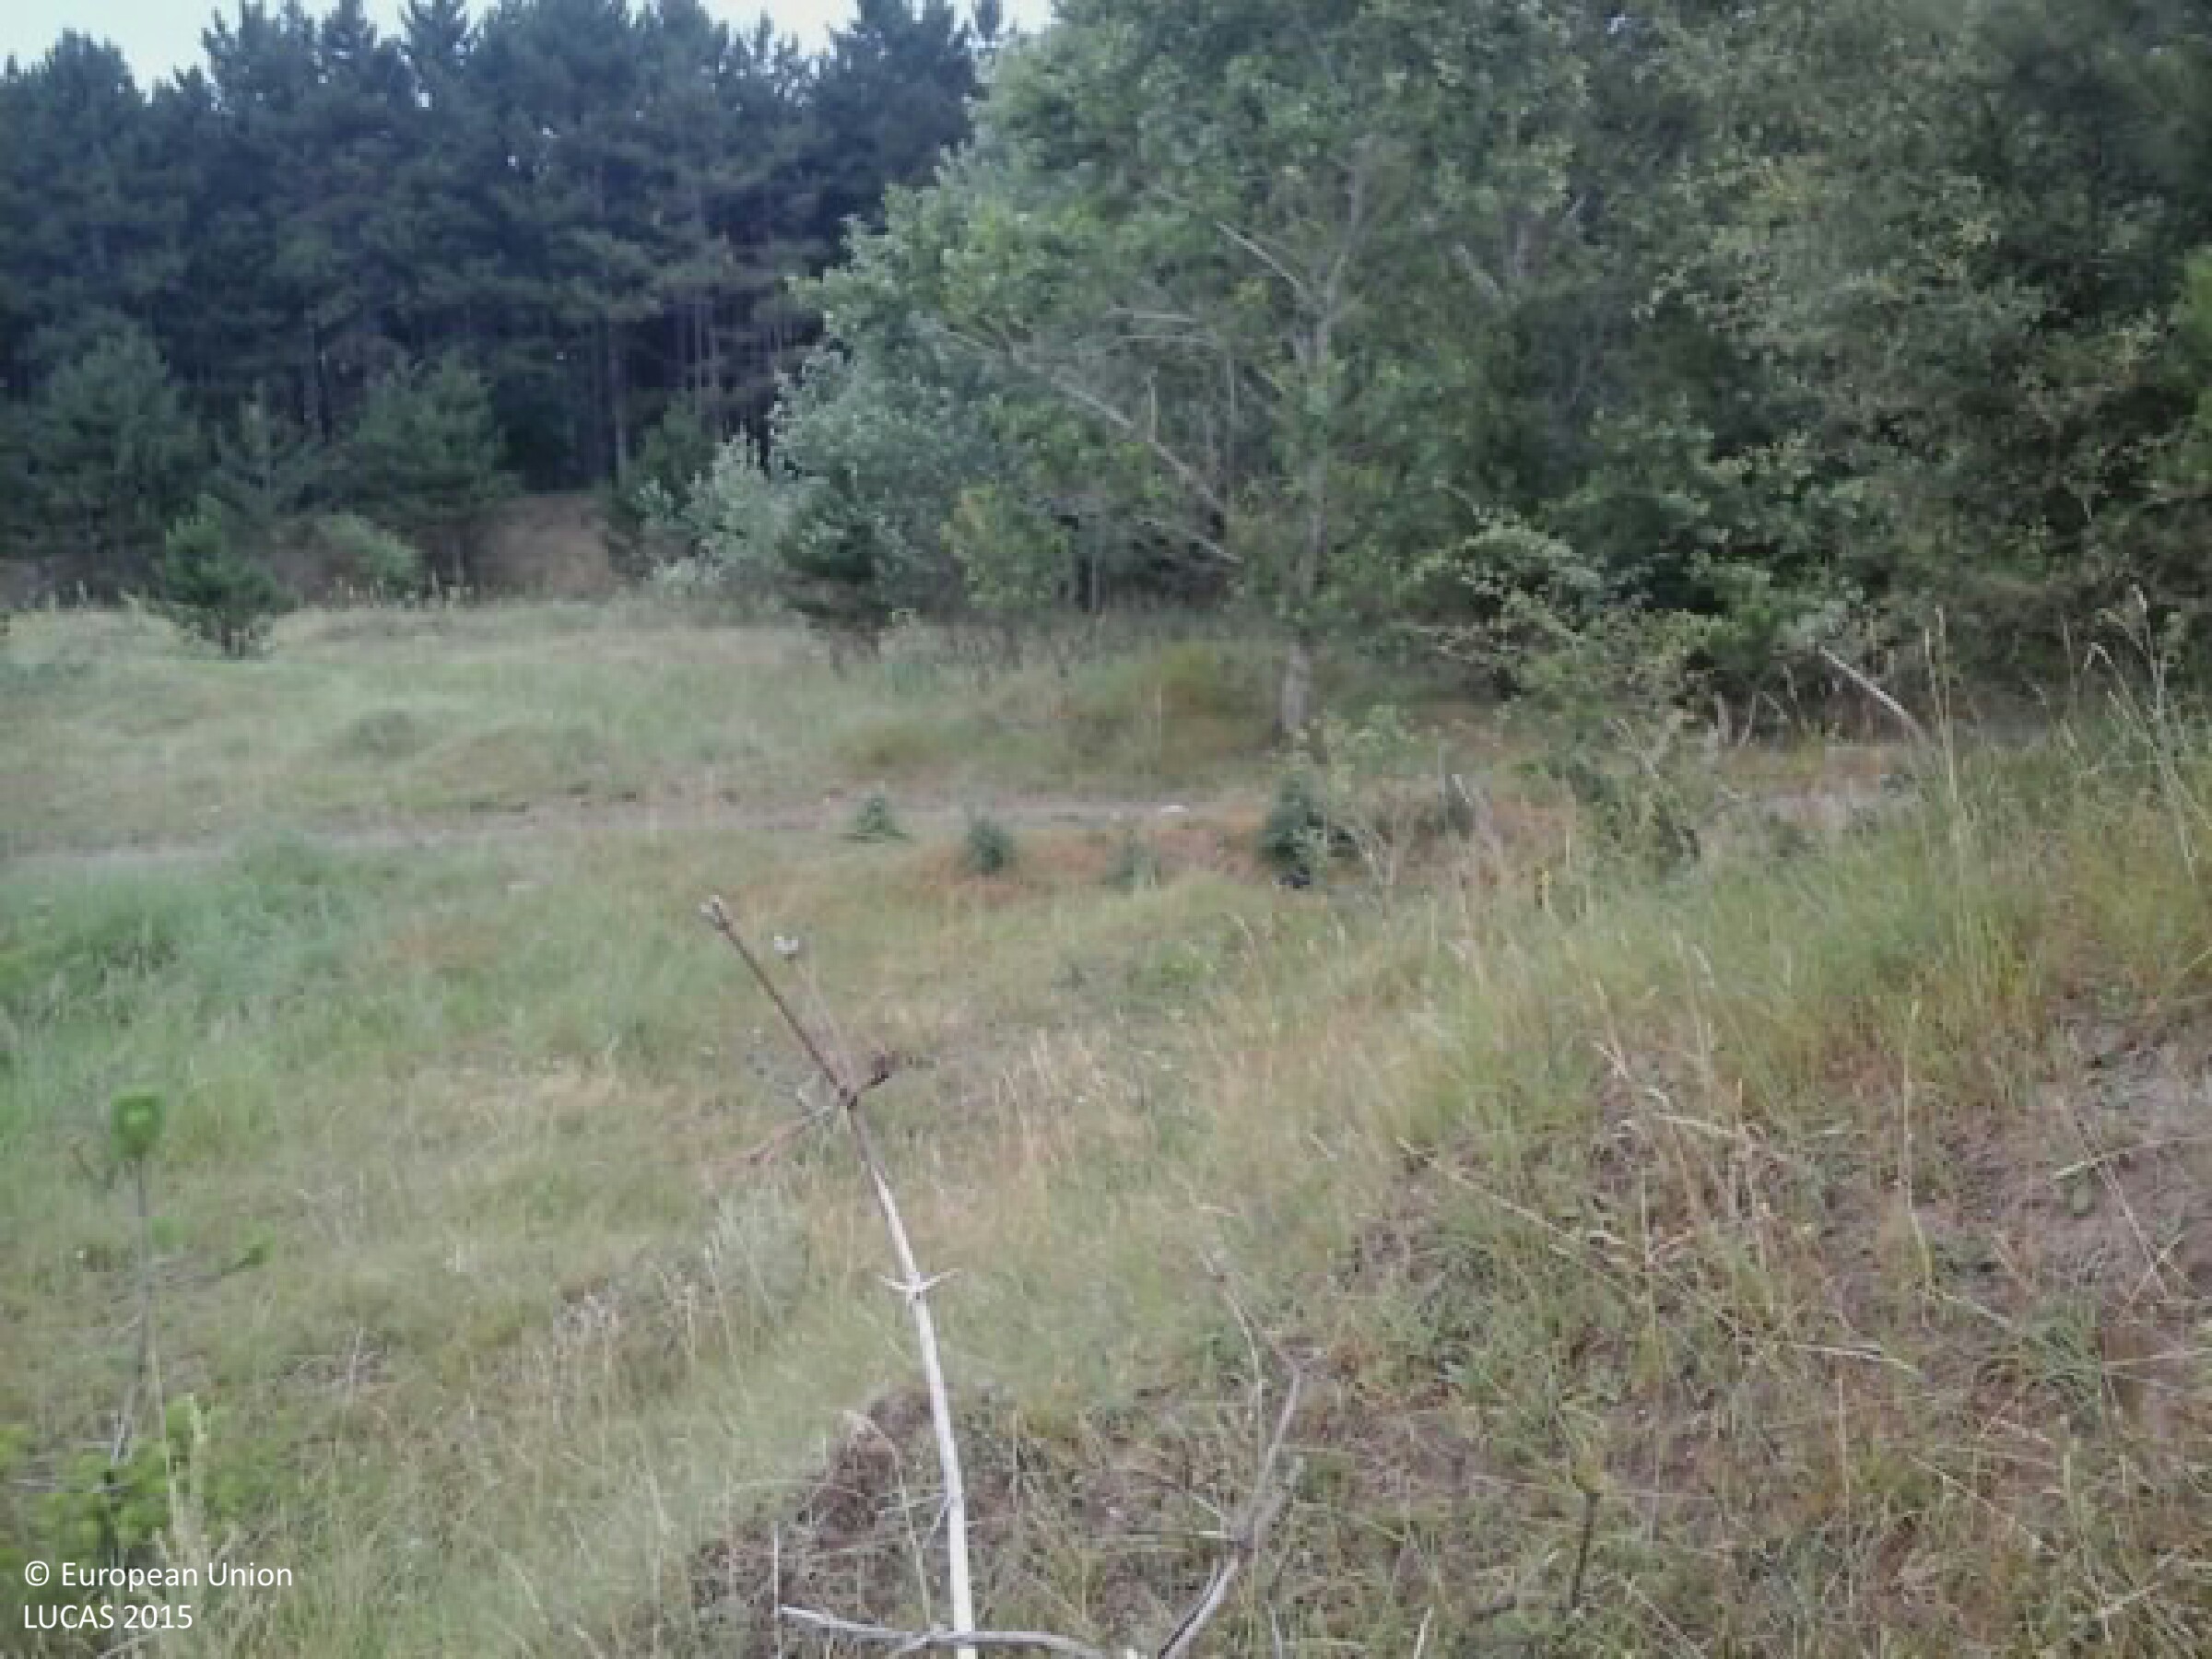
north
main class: Grassland
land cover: Grassland with sparse tree/shrub cover
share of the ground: > 75 %
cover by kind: herbaceous plants 90 %, broadleaved forest trees 5 %, shrubs 5 %
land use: Abandoned areas
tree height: < 5 m
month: June
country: HU
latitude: 46.2786
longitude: 19.0064
